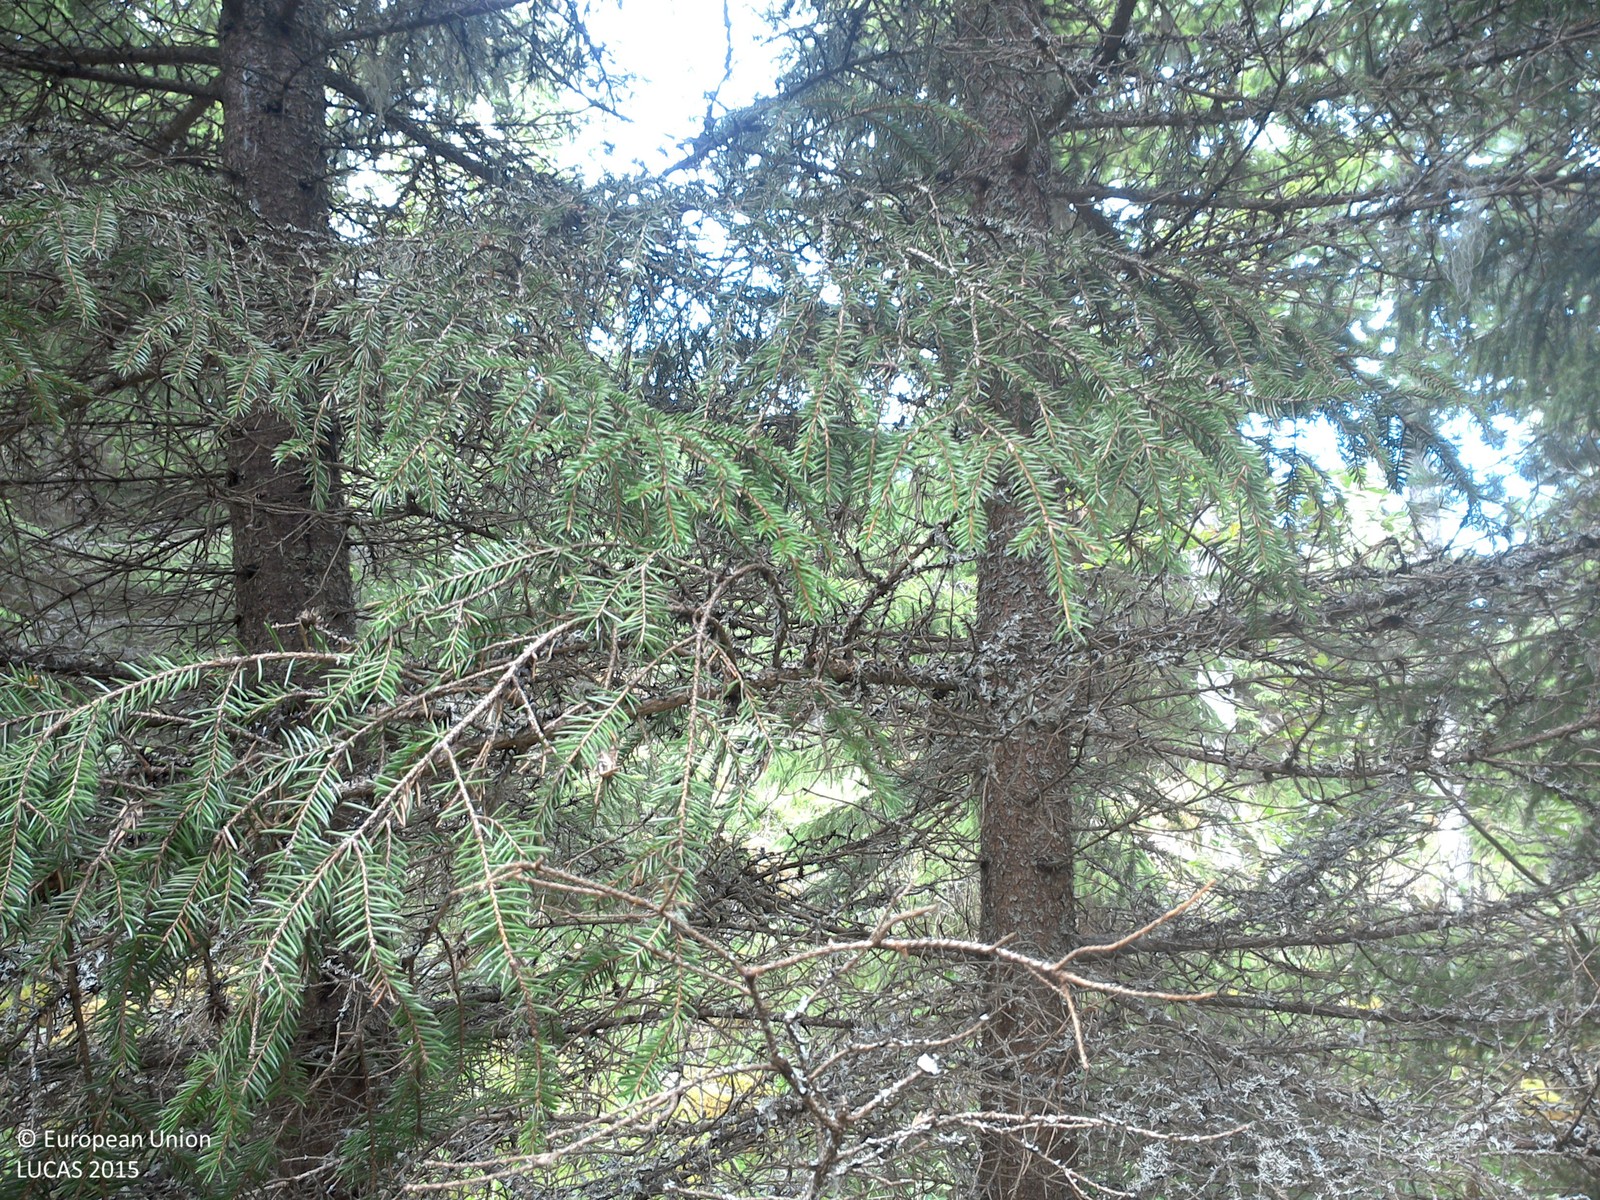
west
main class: Woodland
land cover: Spruce dominated coniferous woodland
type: boreal forest
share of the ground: 50 - 75 %
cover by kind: coniferous forest trees 55 %, lichens and mosses 30 %, herbaceous plants 15 %
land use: Forestry
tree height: > 5 m
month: August
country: SE
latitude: 57.8543
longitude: 15.5061
